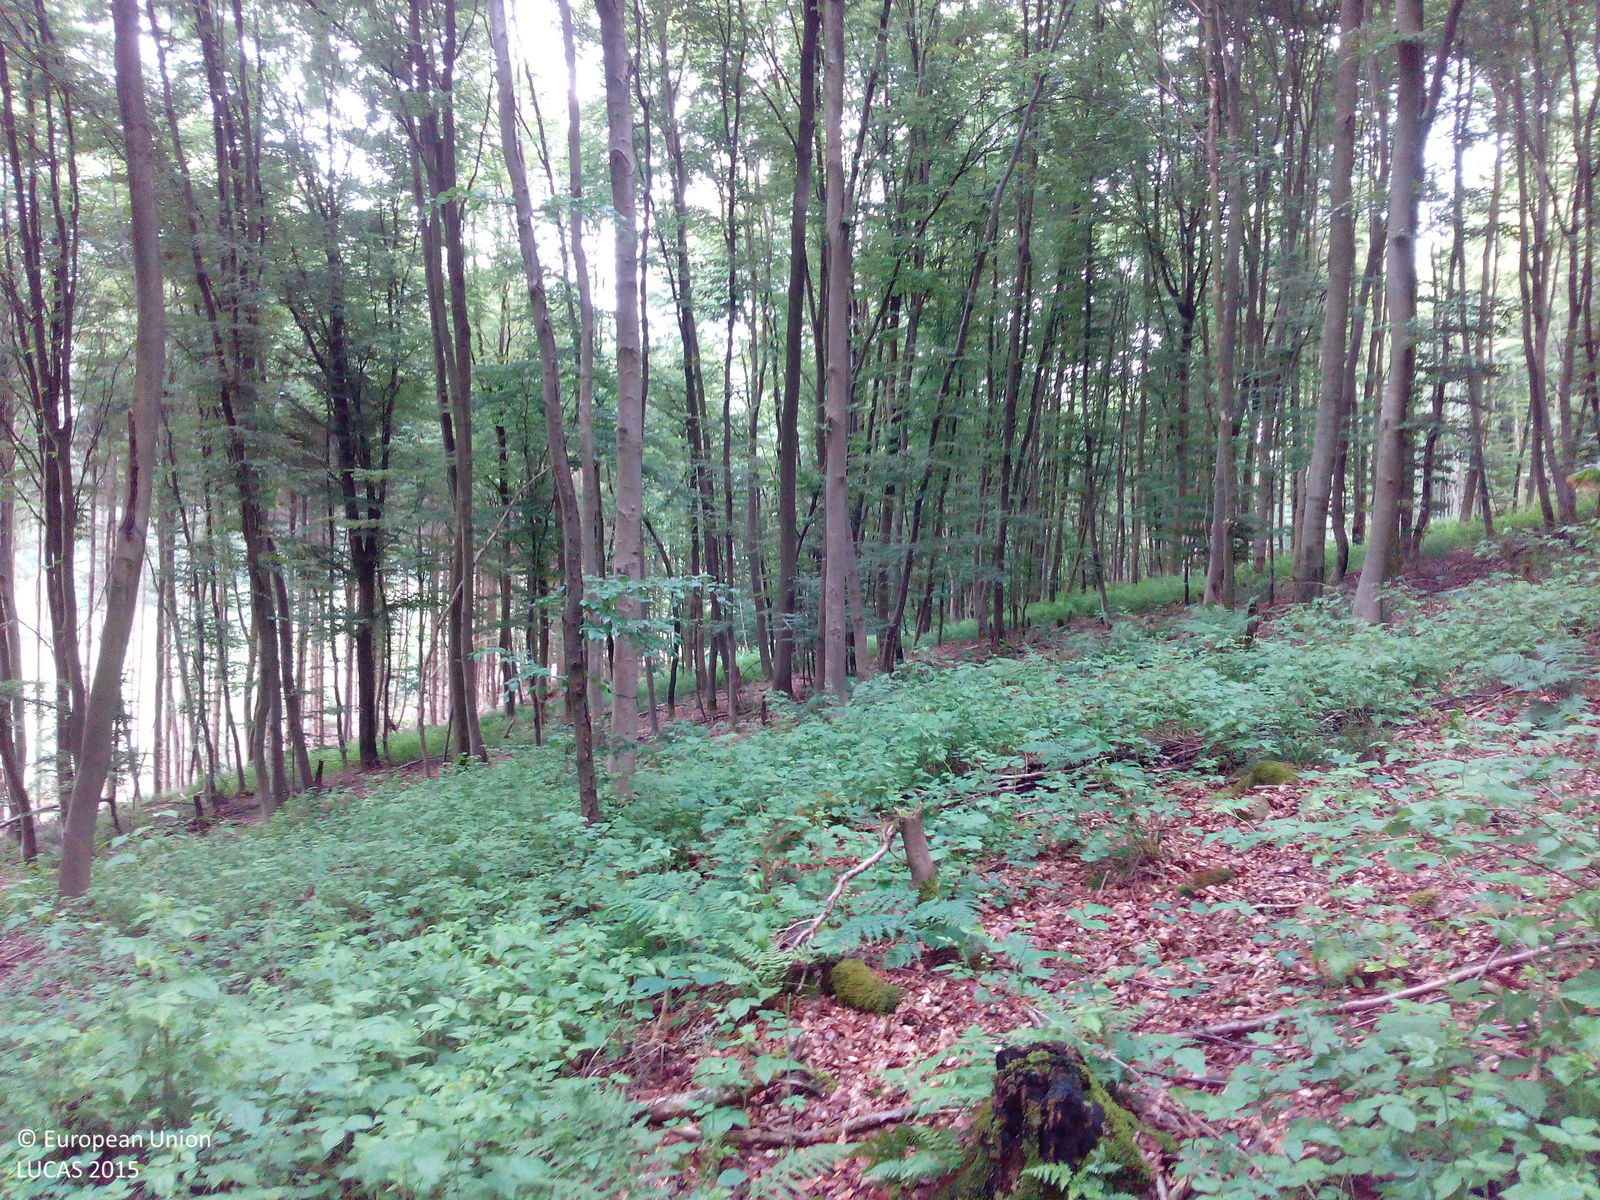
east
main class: Woodland
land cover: Broadleaved woodland
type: beech forest
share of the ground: > 75 %
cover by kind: broadleaved forest trees 85 %, herbaceous plants 10 %, coniferous forest trees 5 %
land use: Forestry
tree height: > 5 m
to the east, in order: Broadleaved woodland; Tracks; Spruce dominated mixed woodland; Spruce dominated coniferous woodland; Grassland without tree/shrub cover; Paved roads, cycling and walking lanes; Grass margins; Broadleaved woodland; Grassland without tree/shrub cover
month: June
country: DE
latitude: 51.6220
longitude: 9.6390
